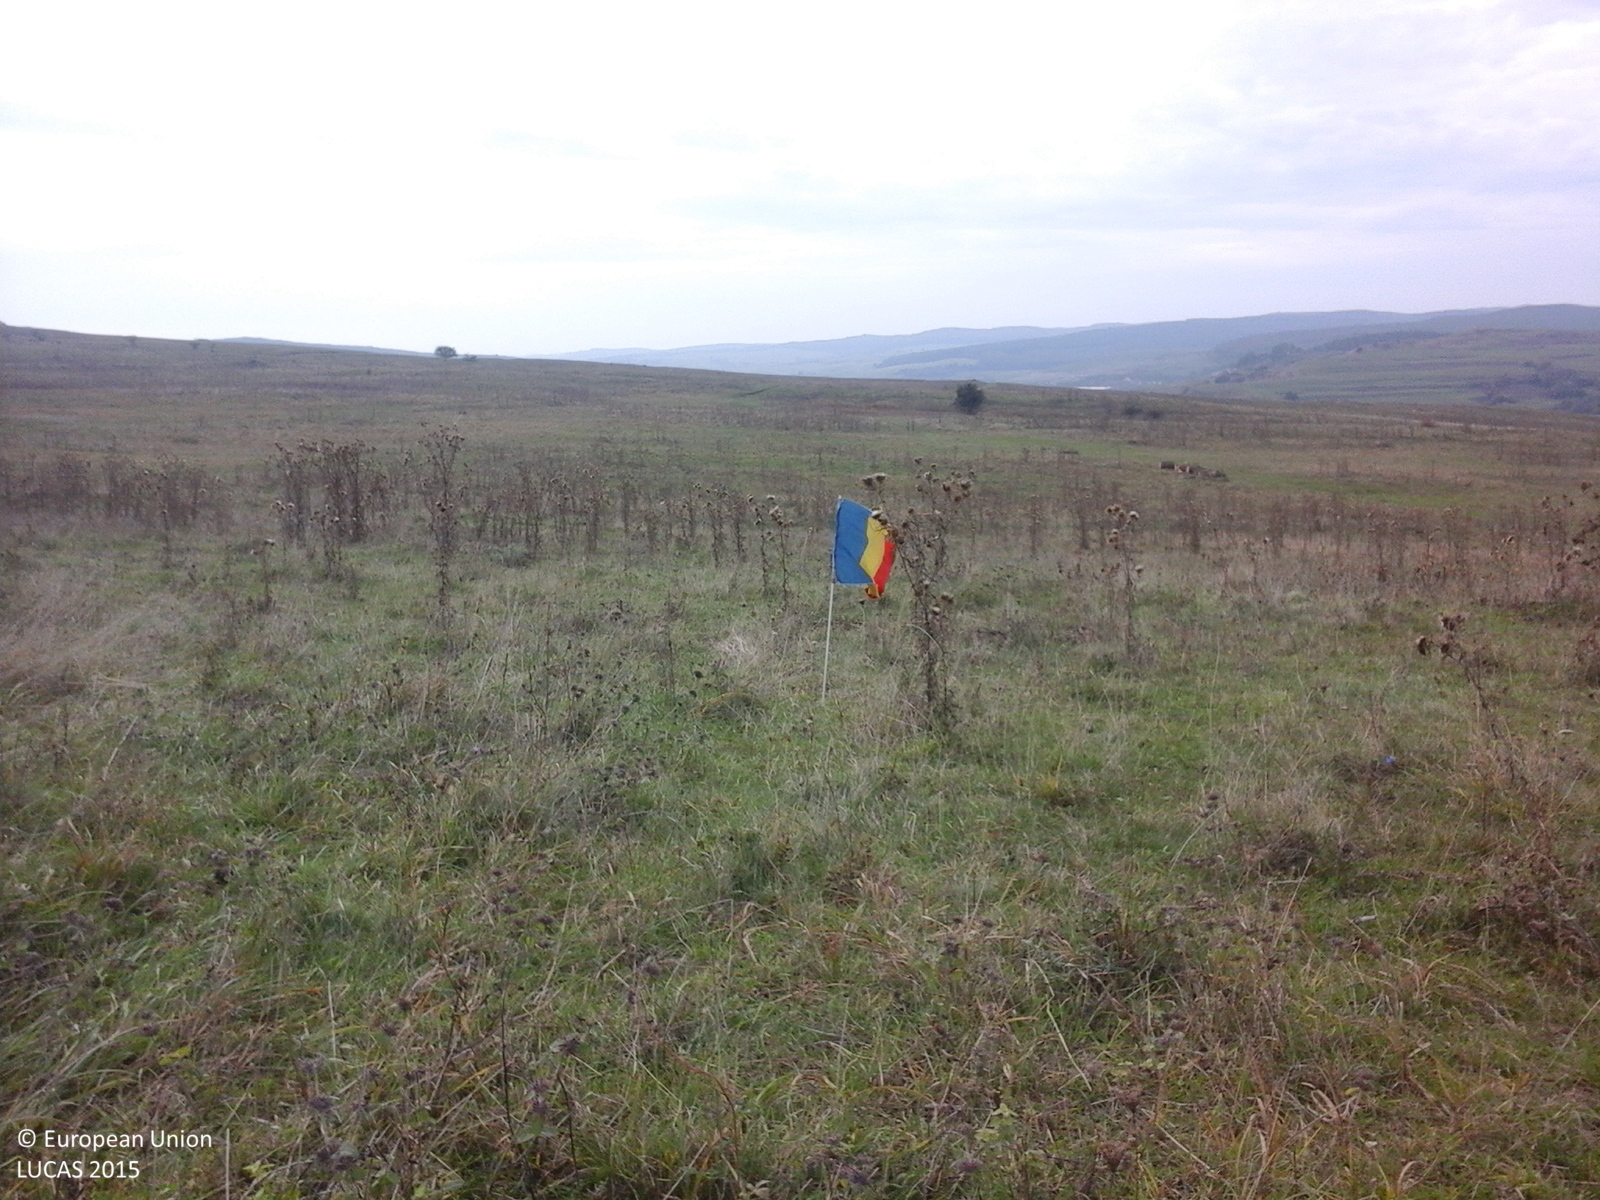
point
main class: Grassland
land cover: Spontaneously vegetated surfaces
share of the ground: > 75 %
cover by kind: herbaceous plants 100 %
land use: Agriculture (excluding fallow land and kitchen gardens)
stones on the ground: < 10 %
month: October
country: RO
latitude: 46.0733
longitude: 24.8699
